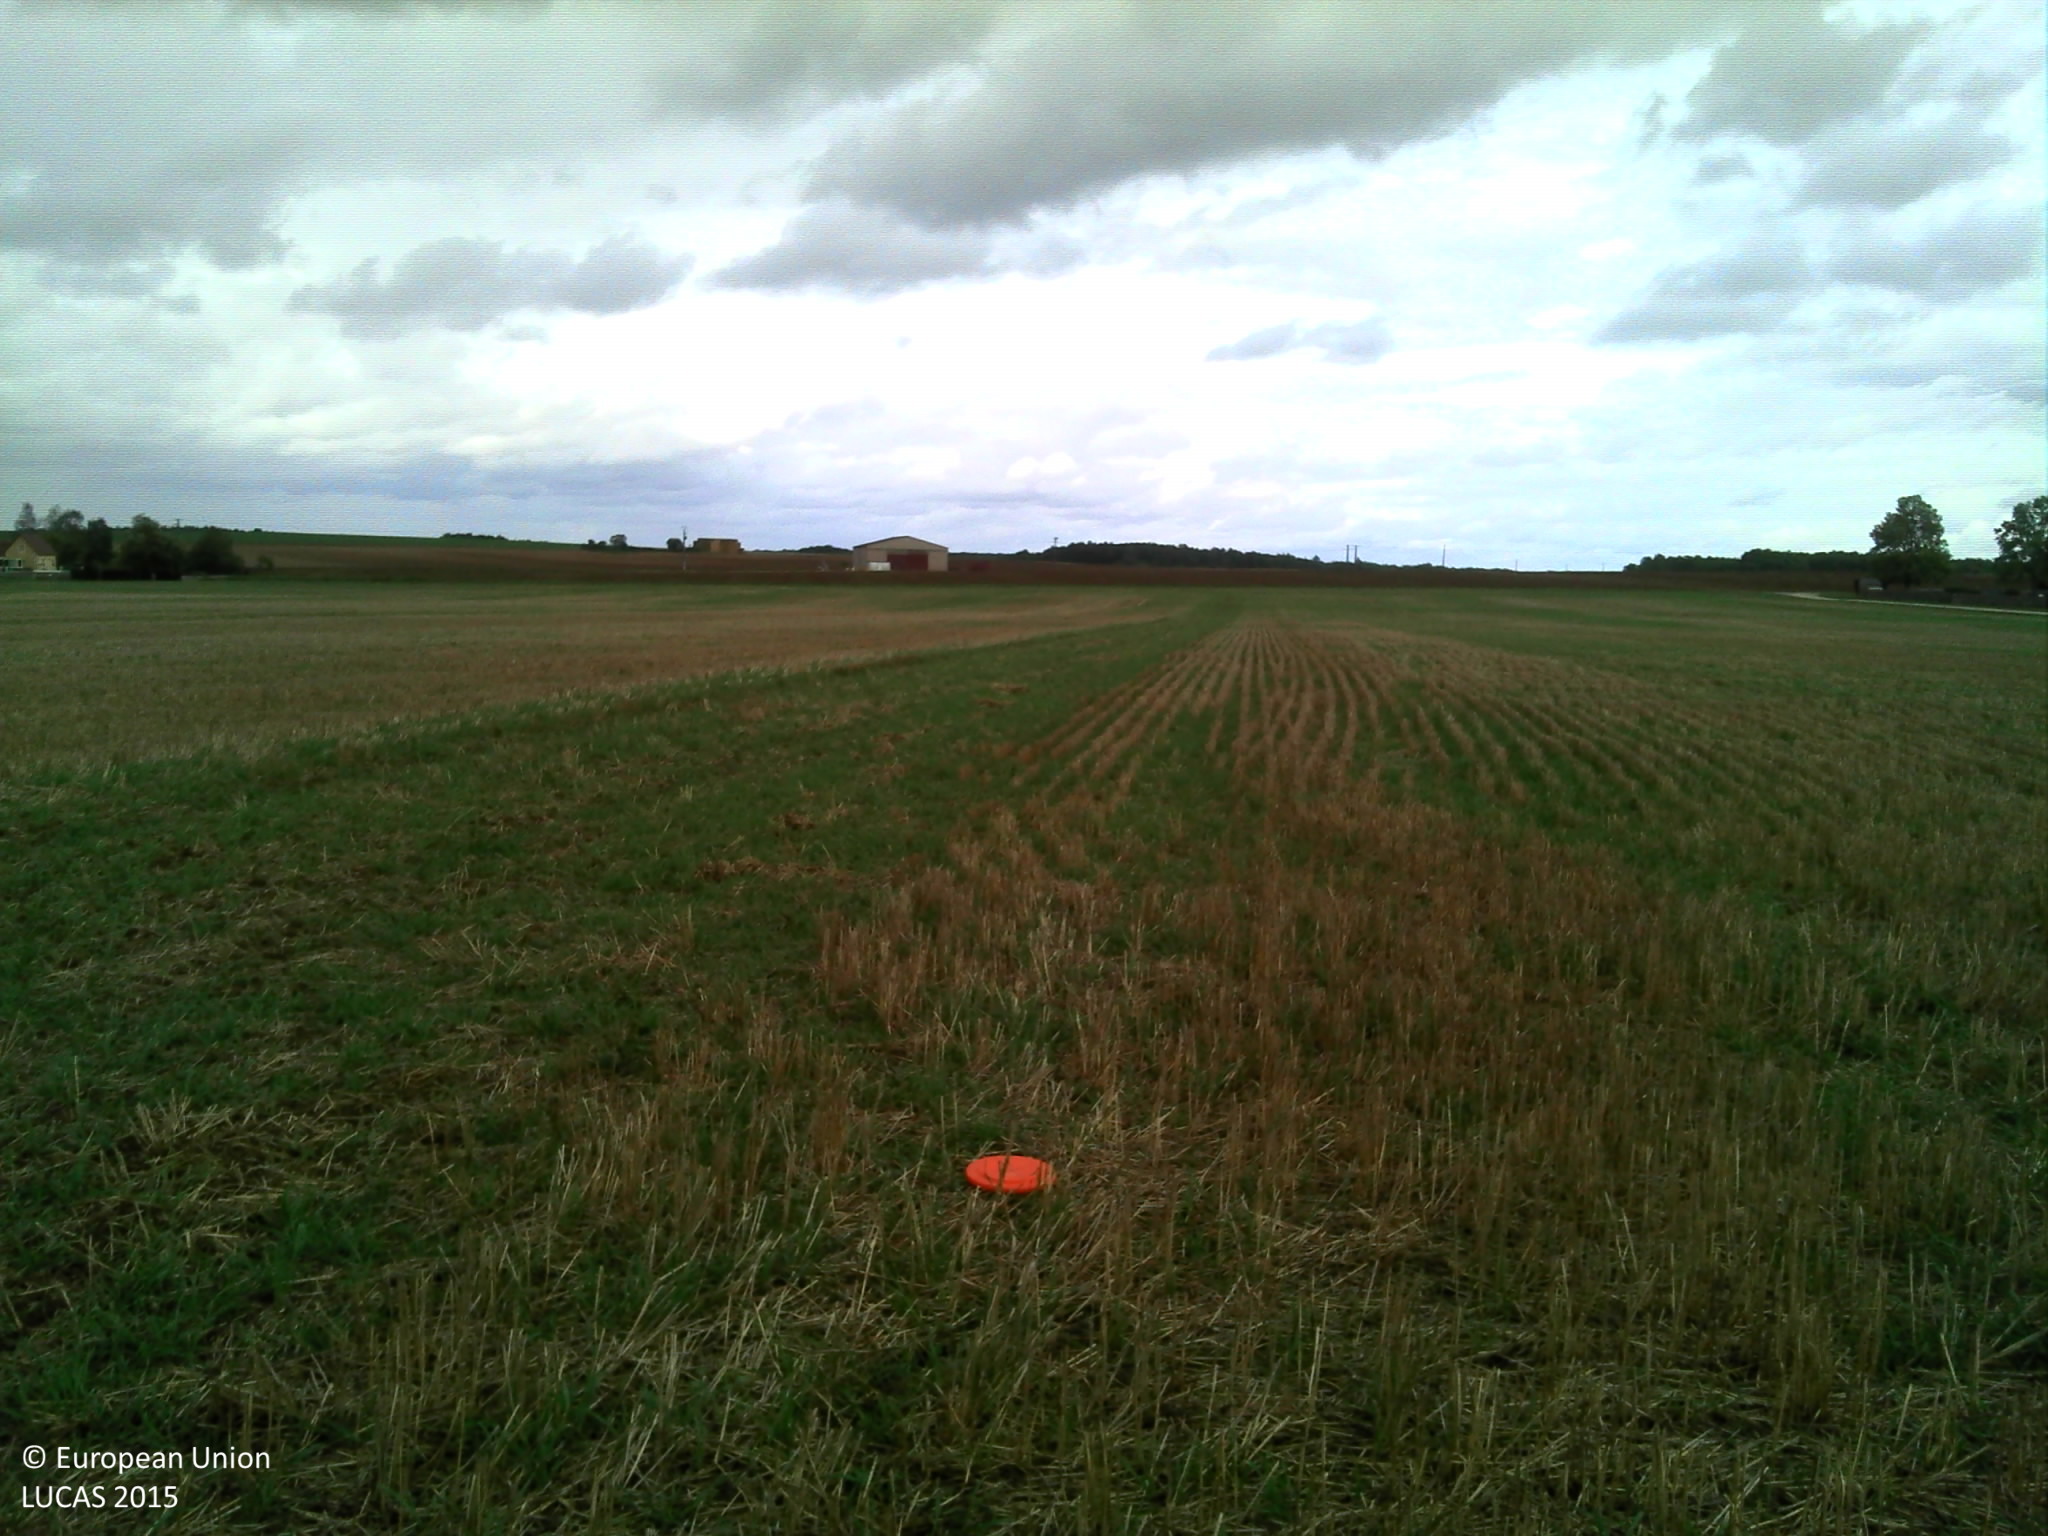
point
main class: Cropland
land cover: Common wheat
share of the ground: 25 - 50 %
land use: Agriculture (excluding fallow land and kitchen gardens)
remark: Harvested field
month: September
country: FR
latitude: 47.7142
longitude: 4.2798
